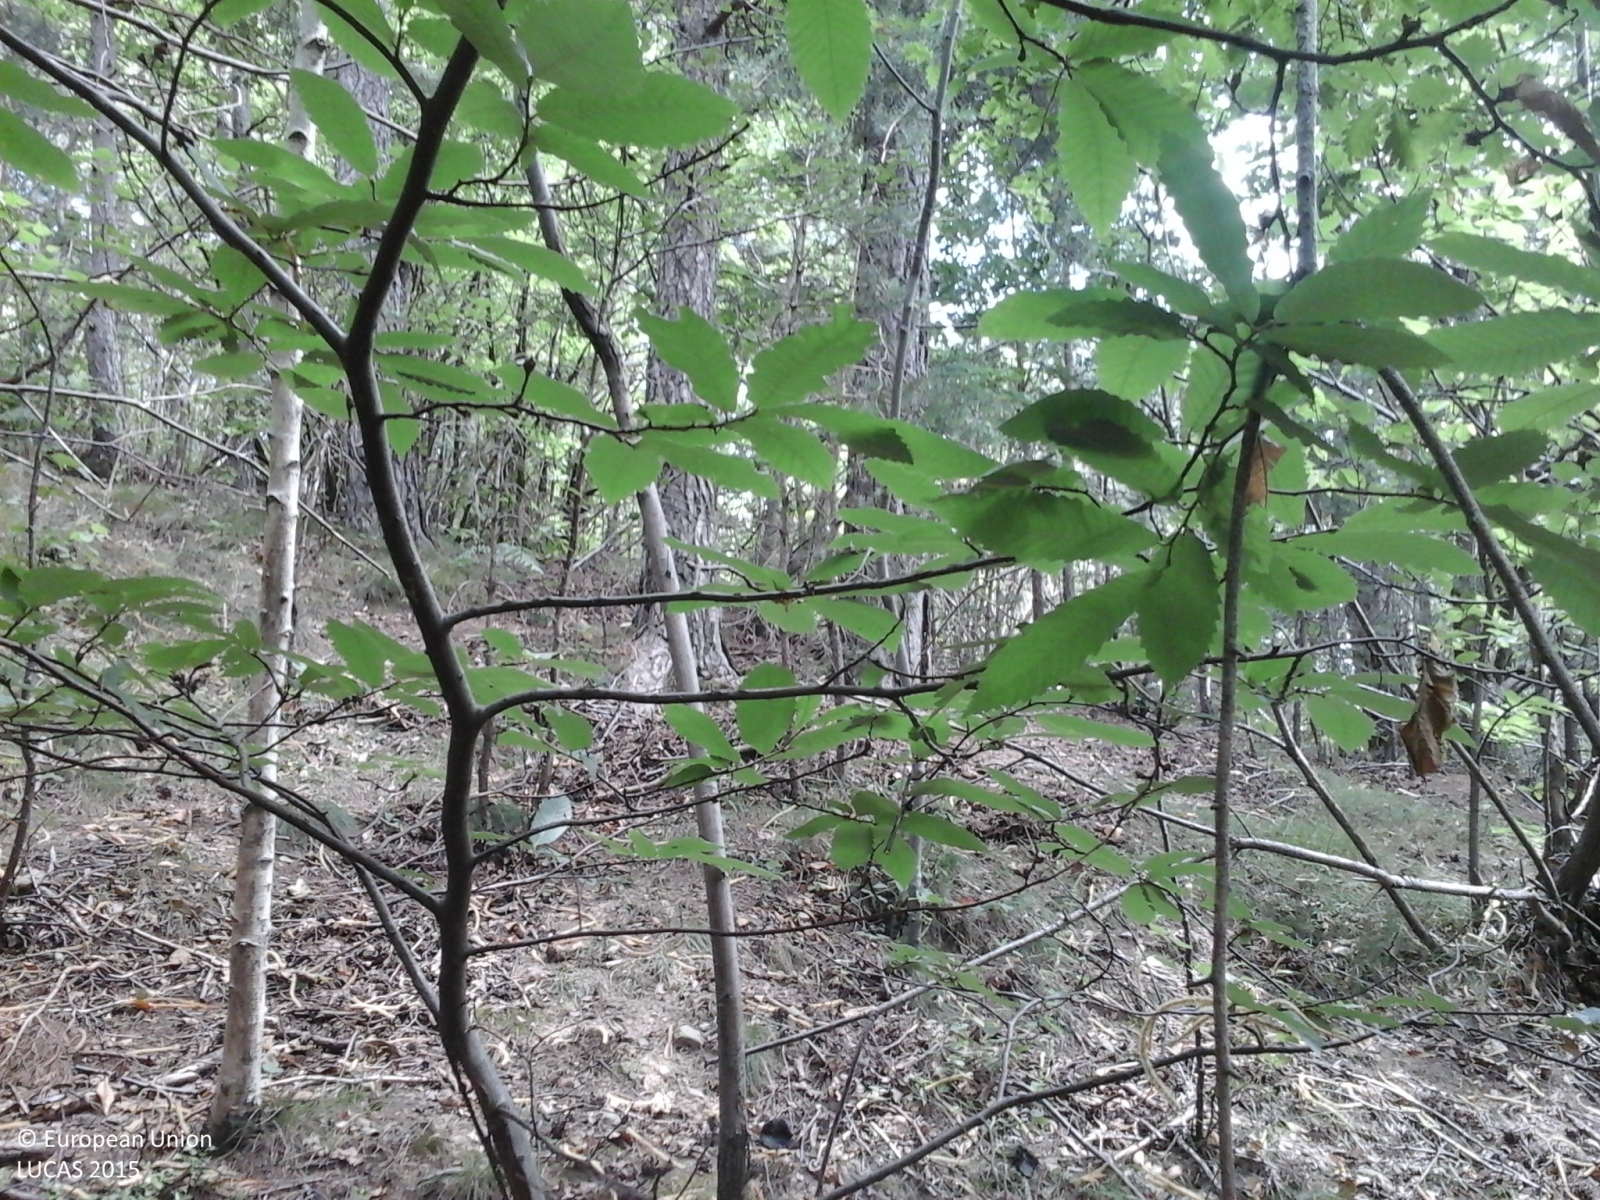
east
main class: Woodland
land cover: Broadleaved woodland
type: thermophilous deciduous forest
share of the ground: > 75 %
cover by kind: broadleaved forest trees 100 %
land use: Semi-natural and natural areas not in use
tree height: > 5 m
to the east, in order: Broadleaved woodland; Tracks; Broadleaved woodland; Tracks; Broadleaved woodland
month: July
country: IT
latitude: 44.8923
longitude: 7.2825
